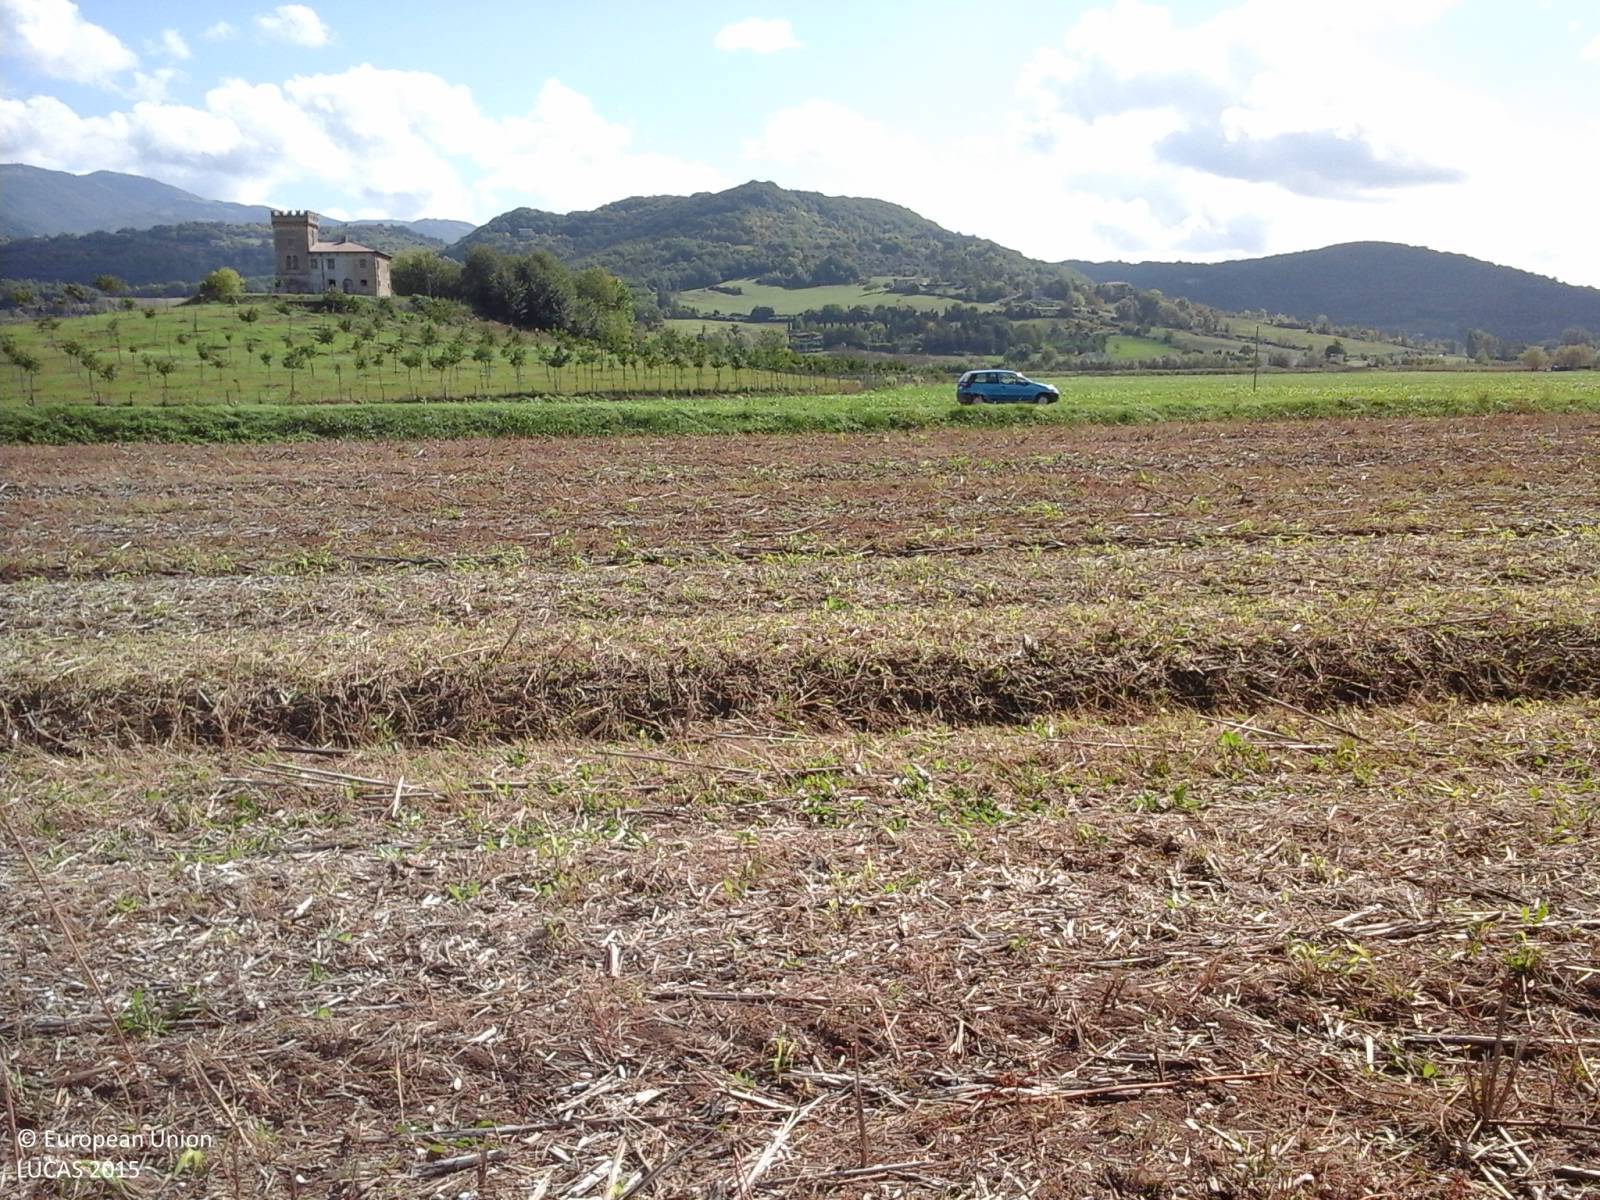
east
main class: Cropland
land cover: Sunflower
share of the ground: < 10 %
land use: Agriculture (excluding fallow land and kitchen gardens)
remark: Harvested field
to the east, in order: Sunflower; Ditches and canals; Sunflower; Grass margins; Ditches and canals; Grass margins; Paved roads, cycling and walking lanes; Grass margins; Ditches and canals; Maize; Ditches and canals; Fences; Broadleaved woodland
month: October
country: IT
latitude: 42.4513
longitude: 12.8481
